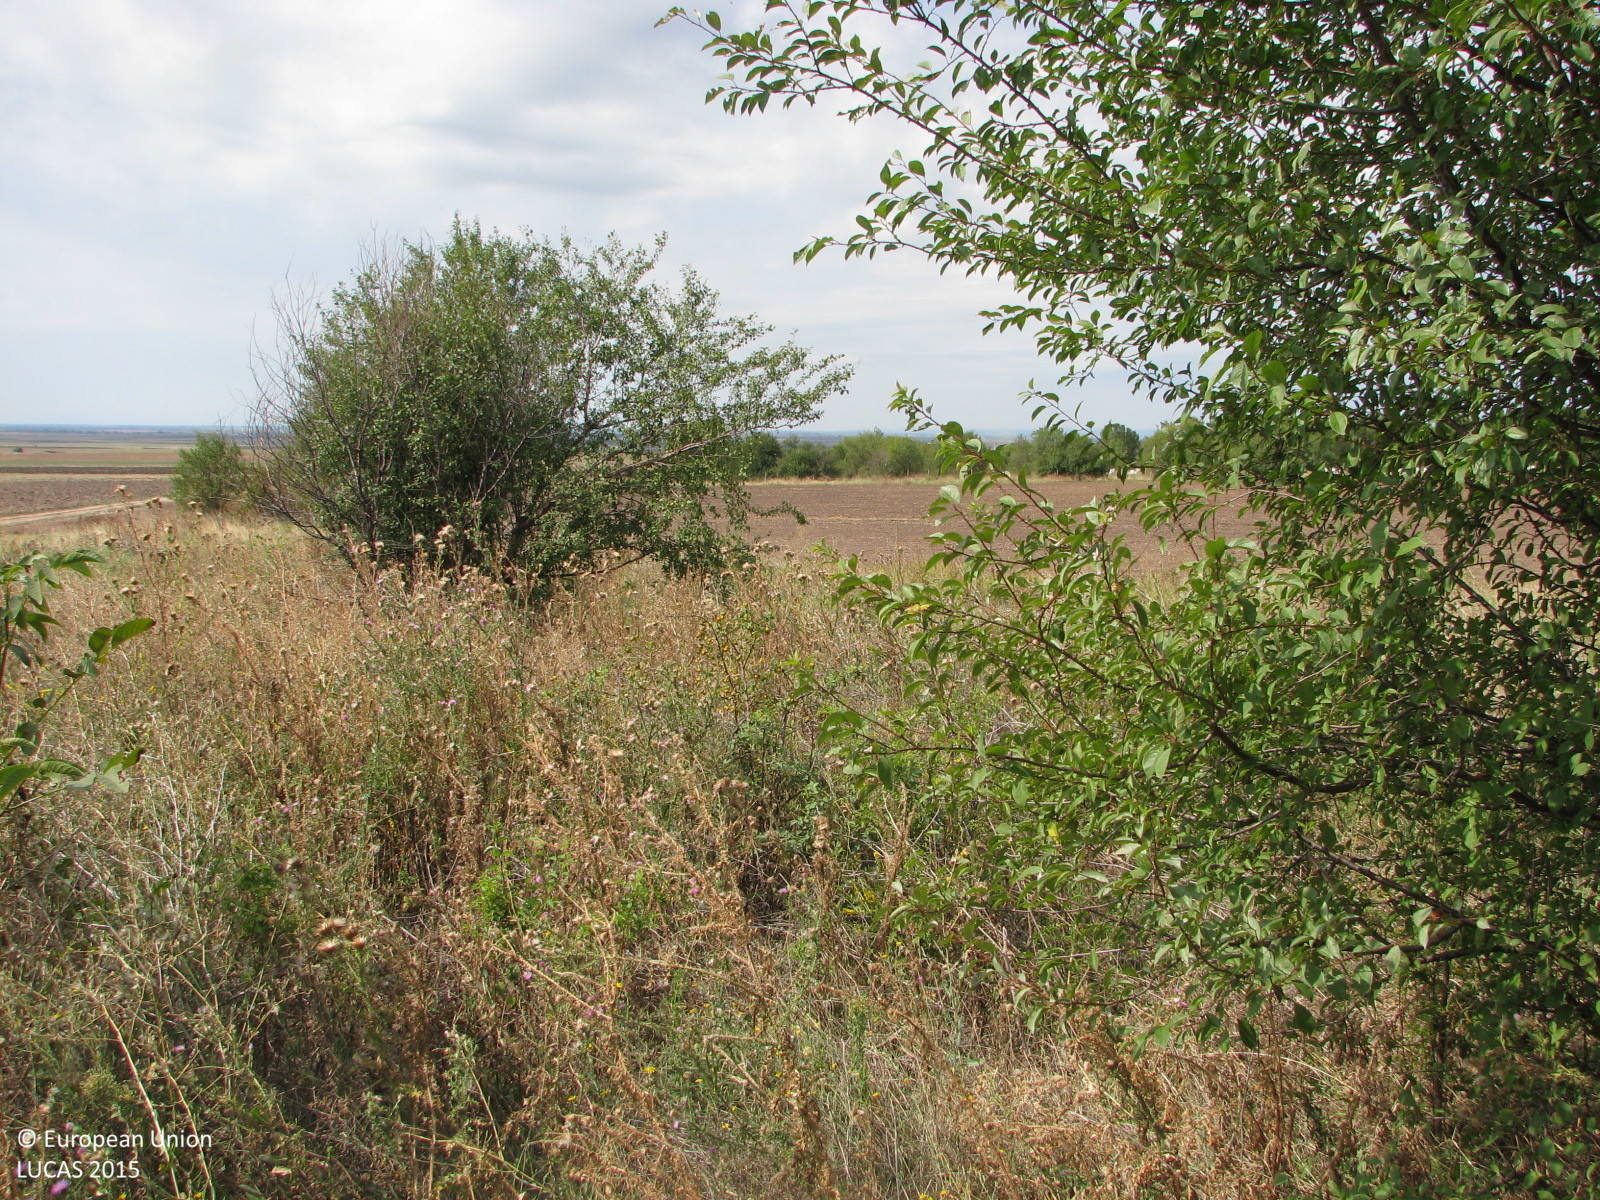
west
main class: Grassland
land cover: Grassland with sparse tree/shrub cover
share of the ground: > 75 %
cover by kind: herbaceous plants 90 %, broadleaved forest trees 5 %, shrubs 5 %
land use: Semi-natural and natural areas not in use
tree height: < 5 m
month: September
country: BG
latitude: 42.4102
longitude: 26.0598
